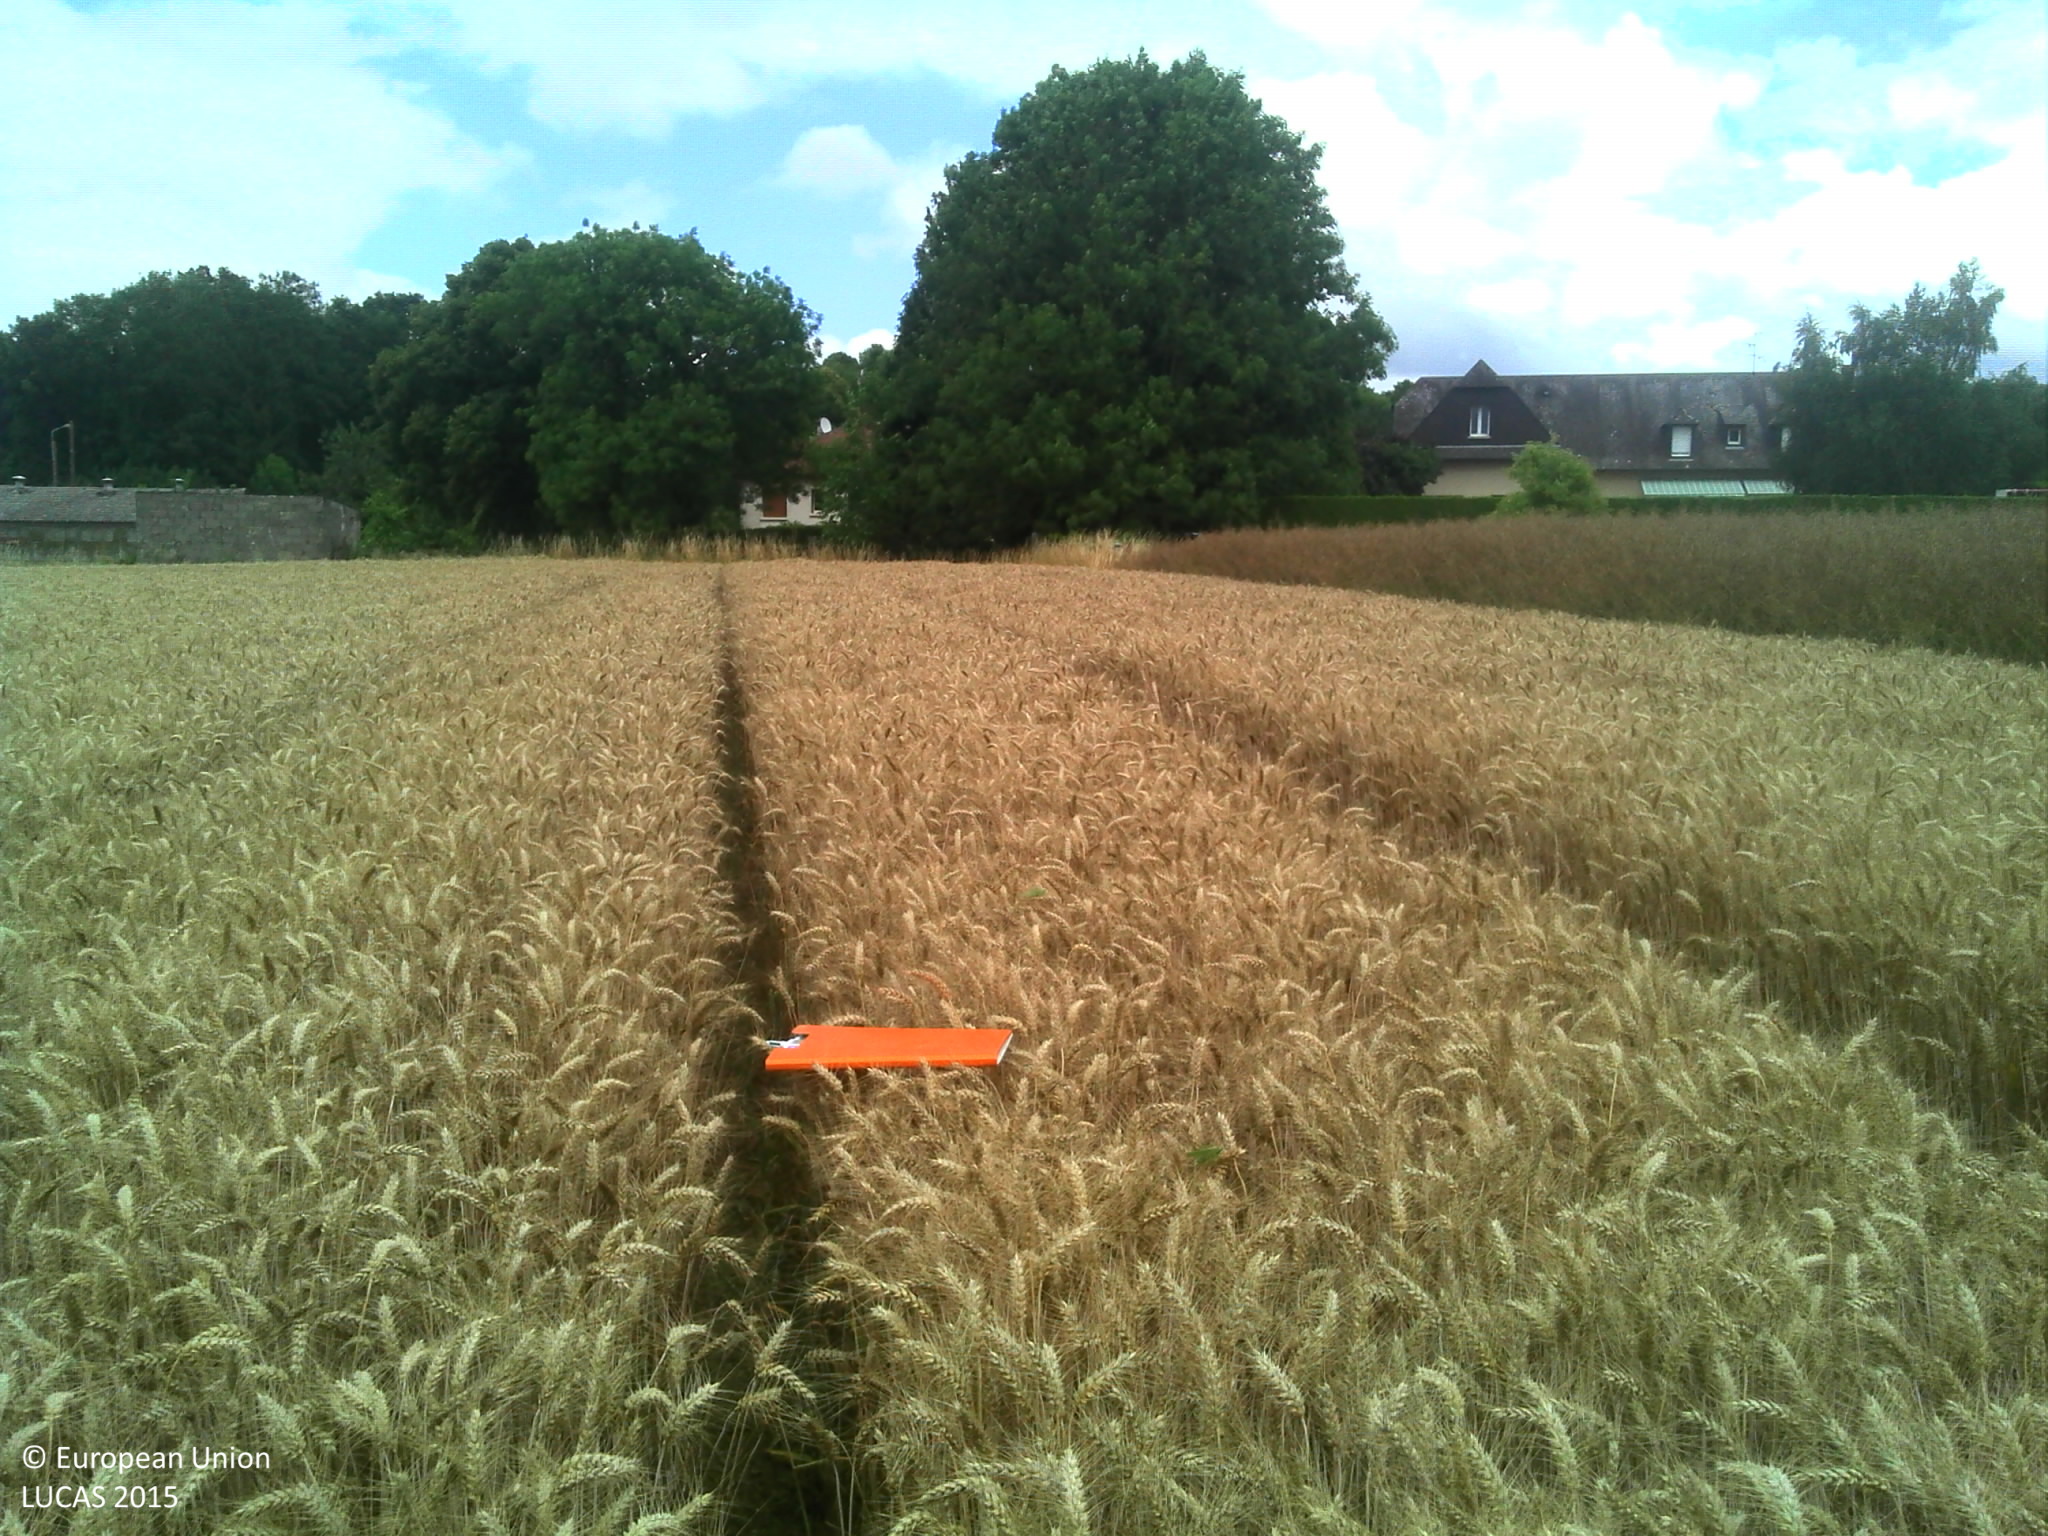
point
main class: Cropland
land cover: Common wheat
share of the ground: > 75 %
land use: Agriculture (excluding fallow land and kitchen gardens)
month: July
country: FR
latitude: 49.8263
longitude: 3.6404
